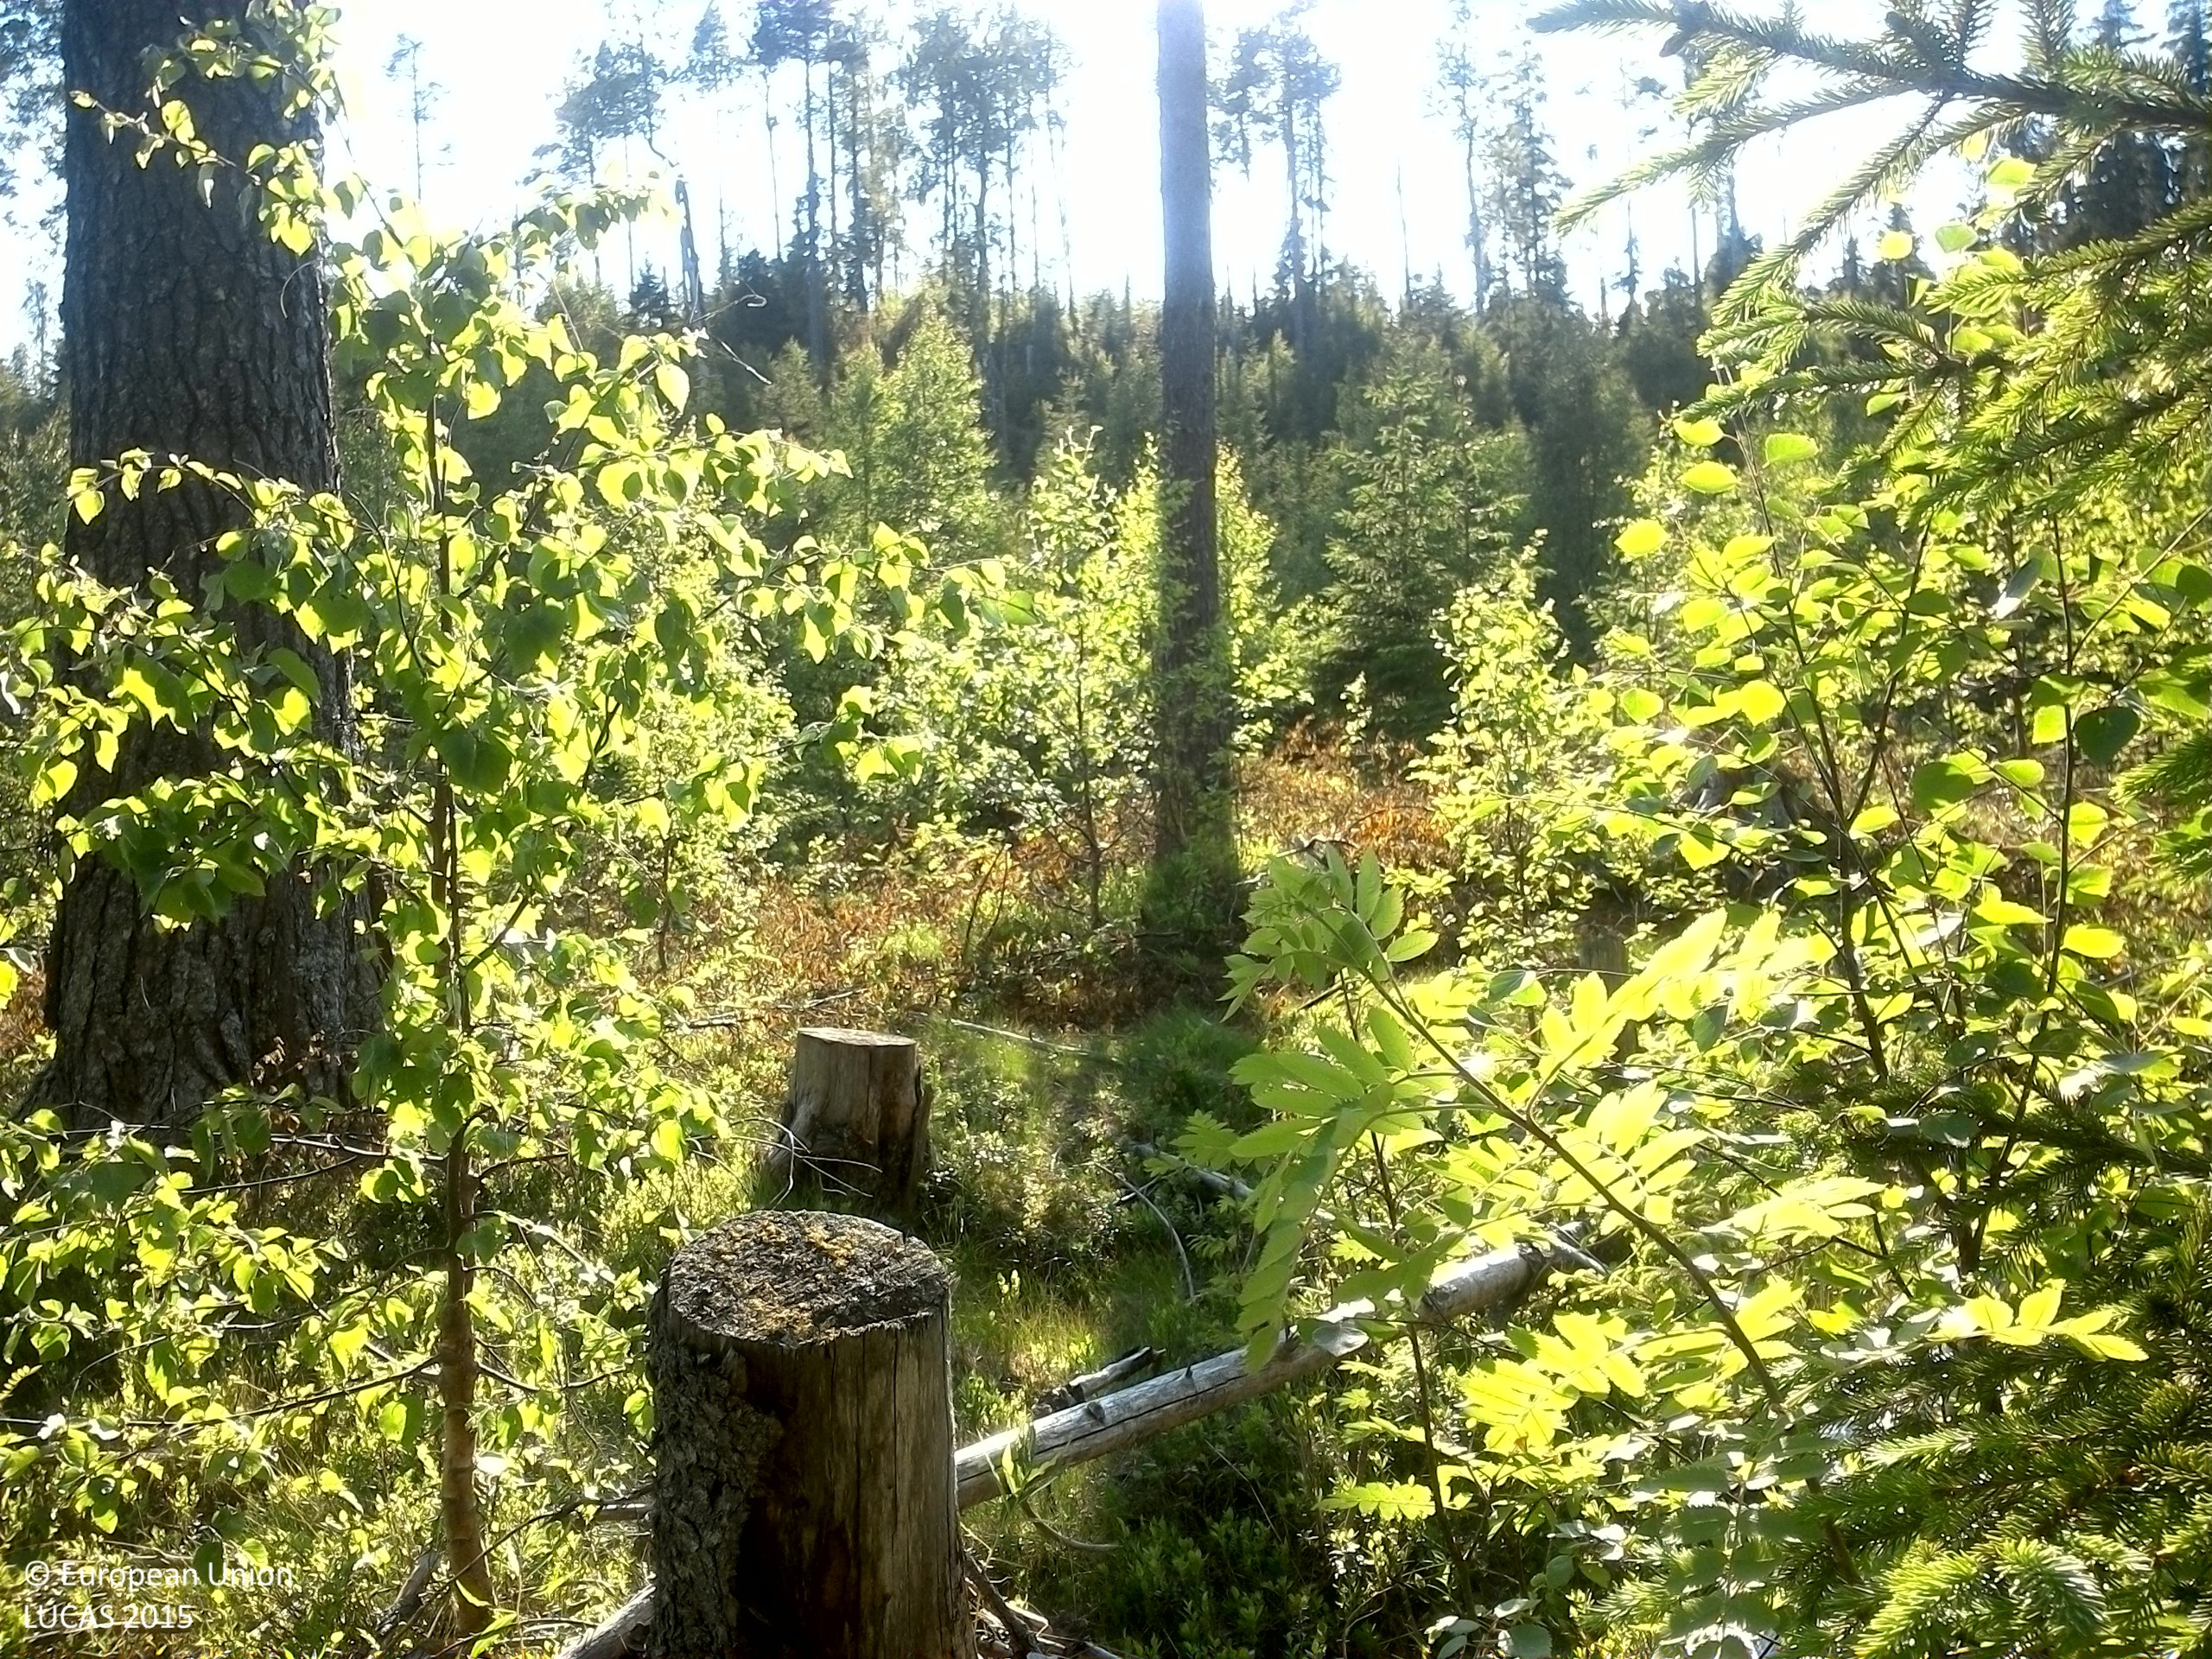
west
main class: Woodland
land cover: Spruce dominated mixed woodland
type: boreal forest
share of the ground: 25 - 50 %
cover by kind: shrubs 60 %, coniferous forest trees 30 %, broadleaved forest trees 10 %
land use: Forestry
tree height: < 5 m
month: July
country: SE
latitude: 62.7980
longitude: 17.2920
